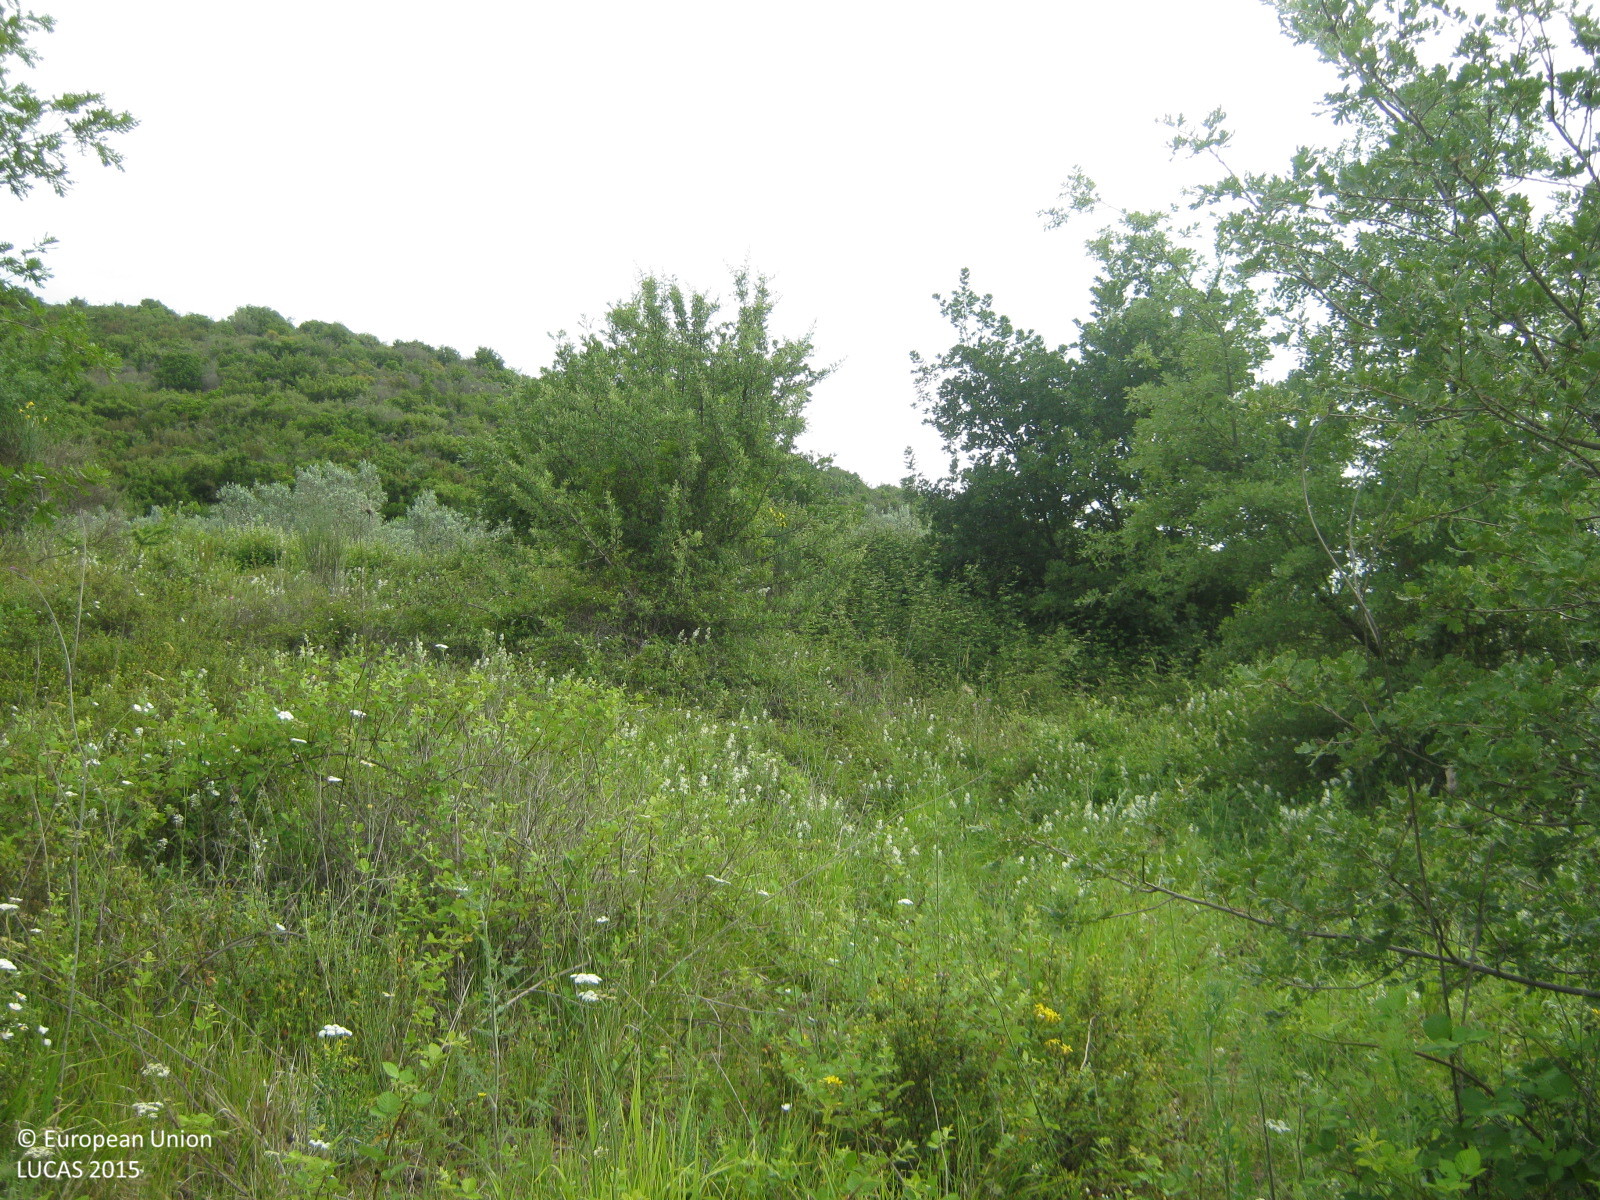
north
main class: Woodland
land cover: Broadleaved woodland
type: thermophilous deciduous forest
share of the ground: 50 - 75 %
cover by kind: broadleaved forest trees 70 %, herbaceous plants 25 %, shrubs 5 %
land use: Semi-natural and natural areas not in use
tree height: > 5 m
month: May
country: GR
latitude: 38.5510
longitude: 21.3169
